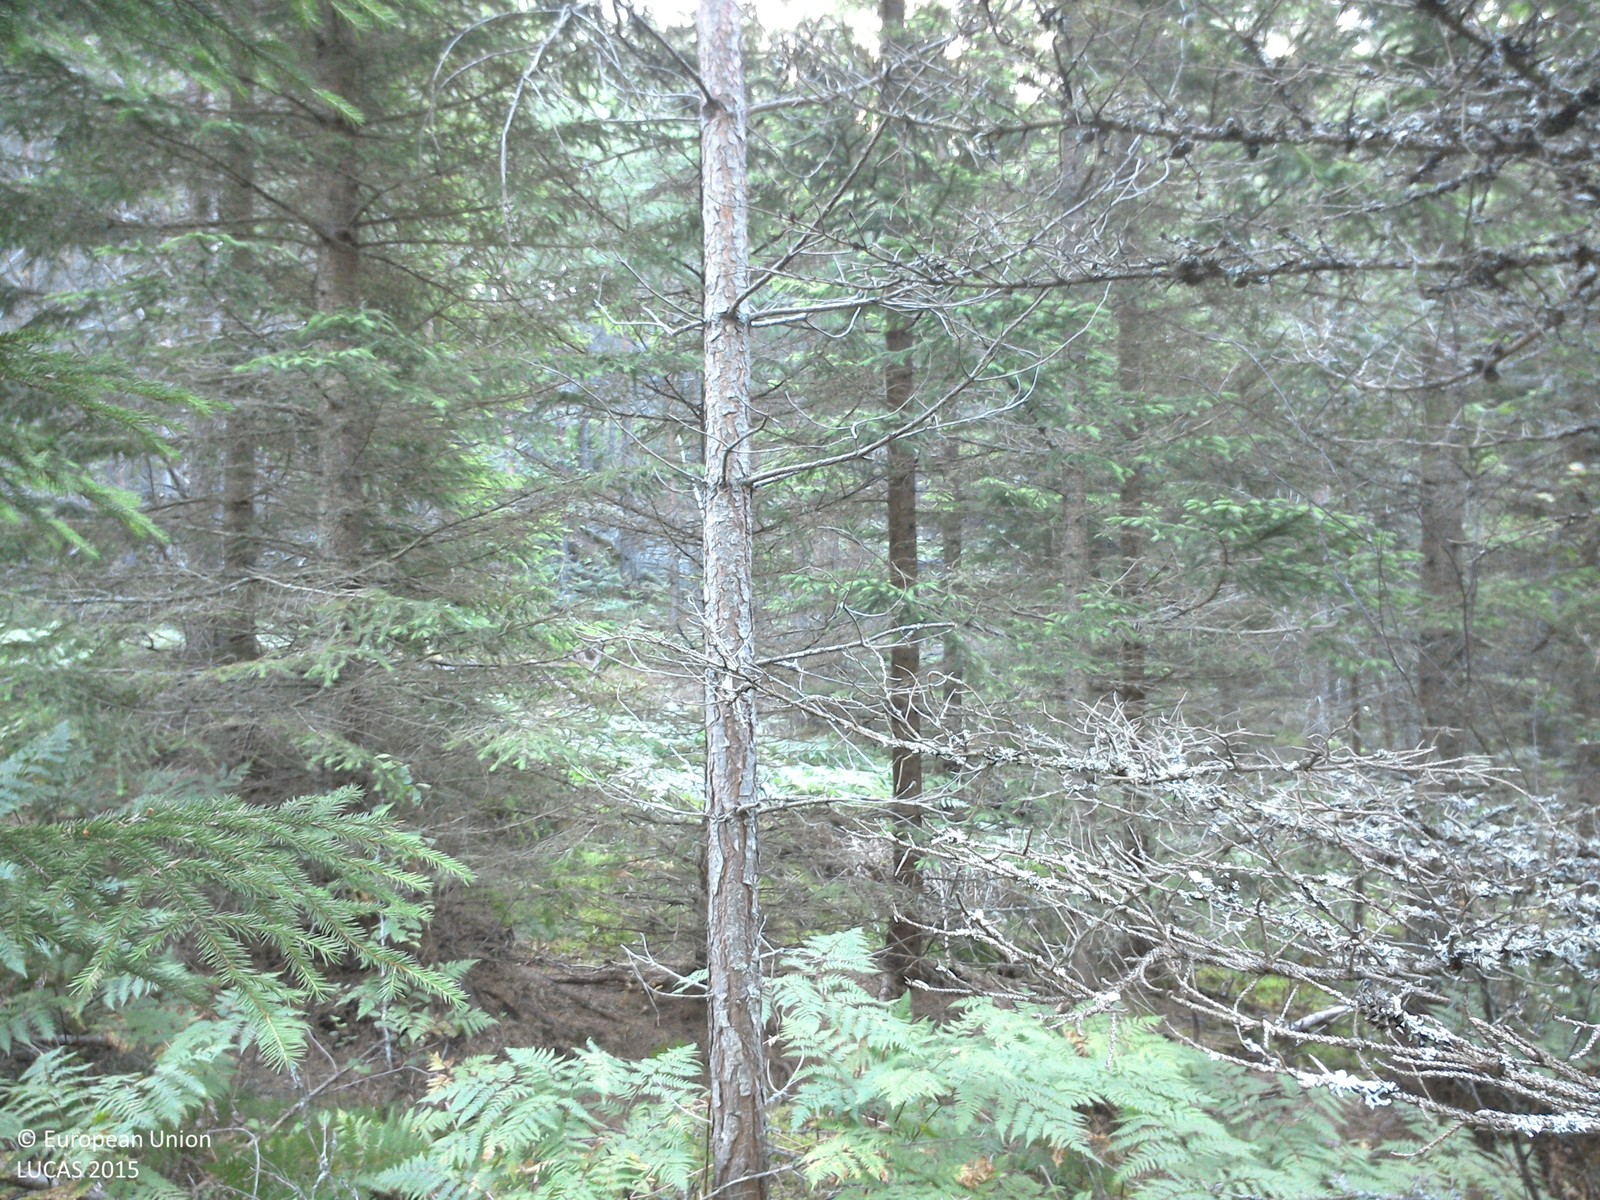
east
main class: Woodland
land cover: Spruce dominated coniferous woodland
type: boreal forest
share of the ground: 50 - 75 %
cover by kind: coniferous forest trees 60 %, herbaceous plants 30 %, lichens and mosses 10 %
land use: Forestry
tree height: > 5 m
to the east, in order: Spruce dominated coniferous woodland; Pine dominated coniferous woodland; Spruce dominated coniferous woodland; Spruce dominated mixed woodland; Broadleaved woodland
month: August
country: SE
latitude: 57.8893
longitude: 15.9508
